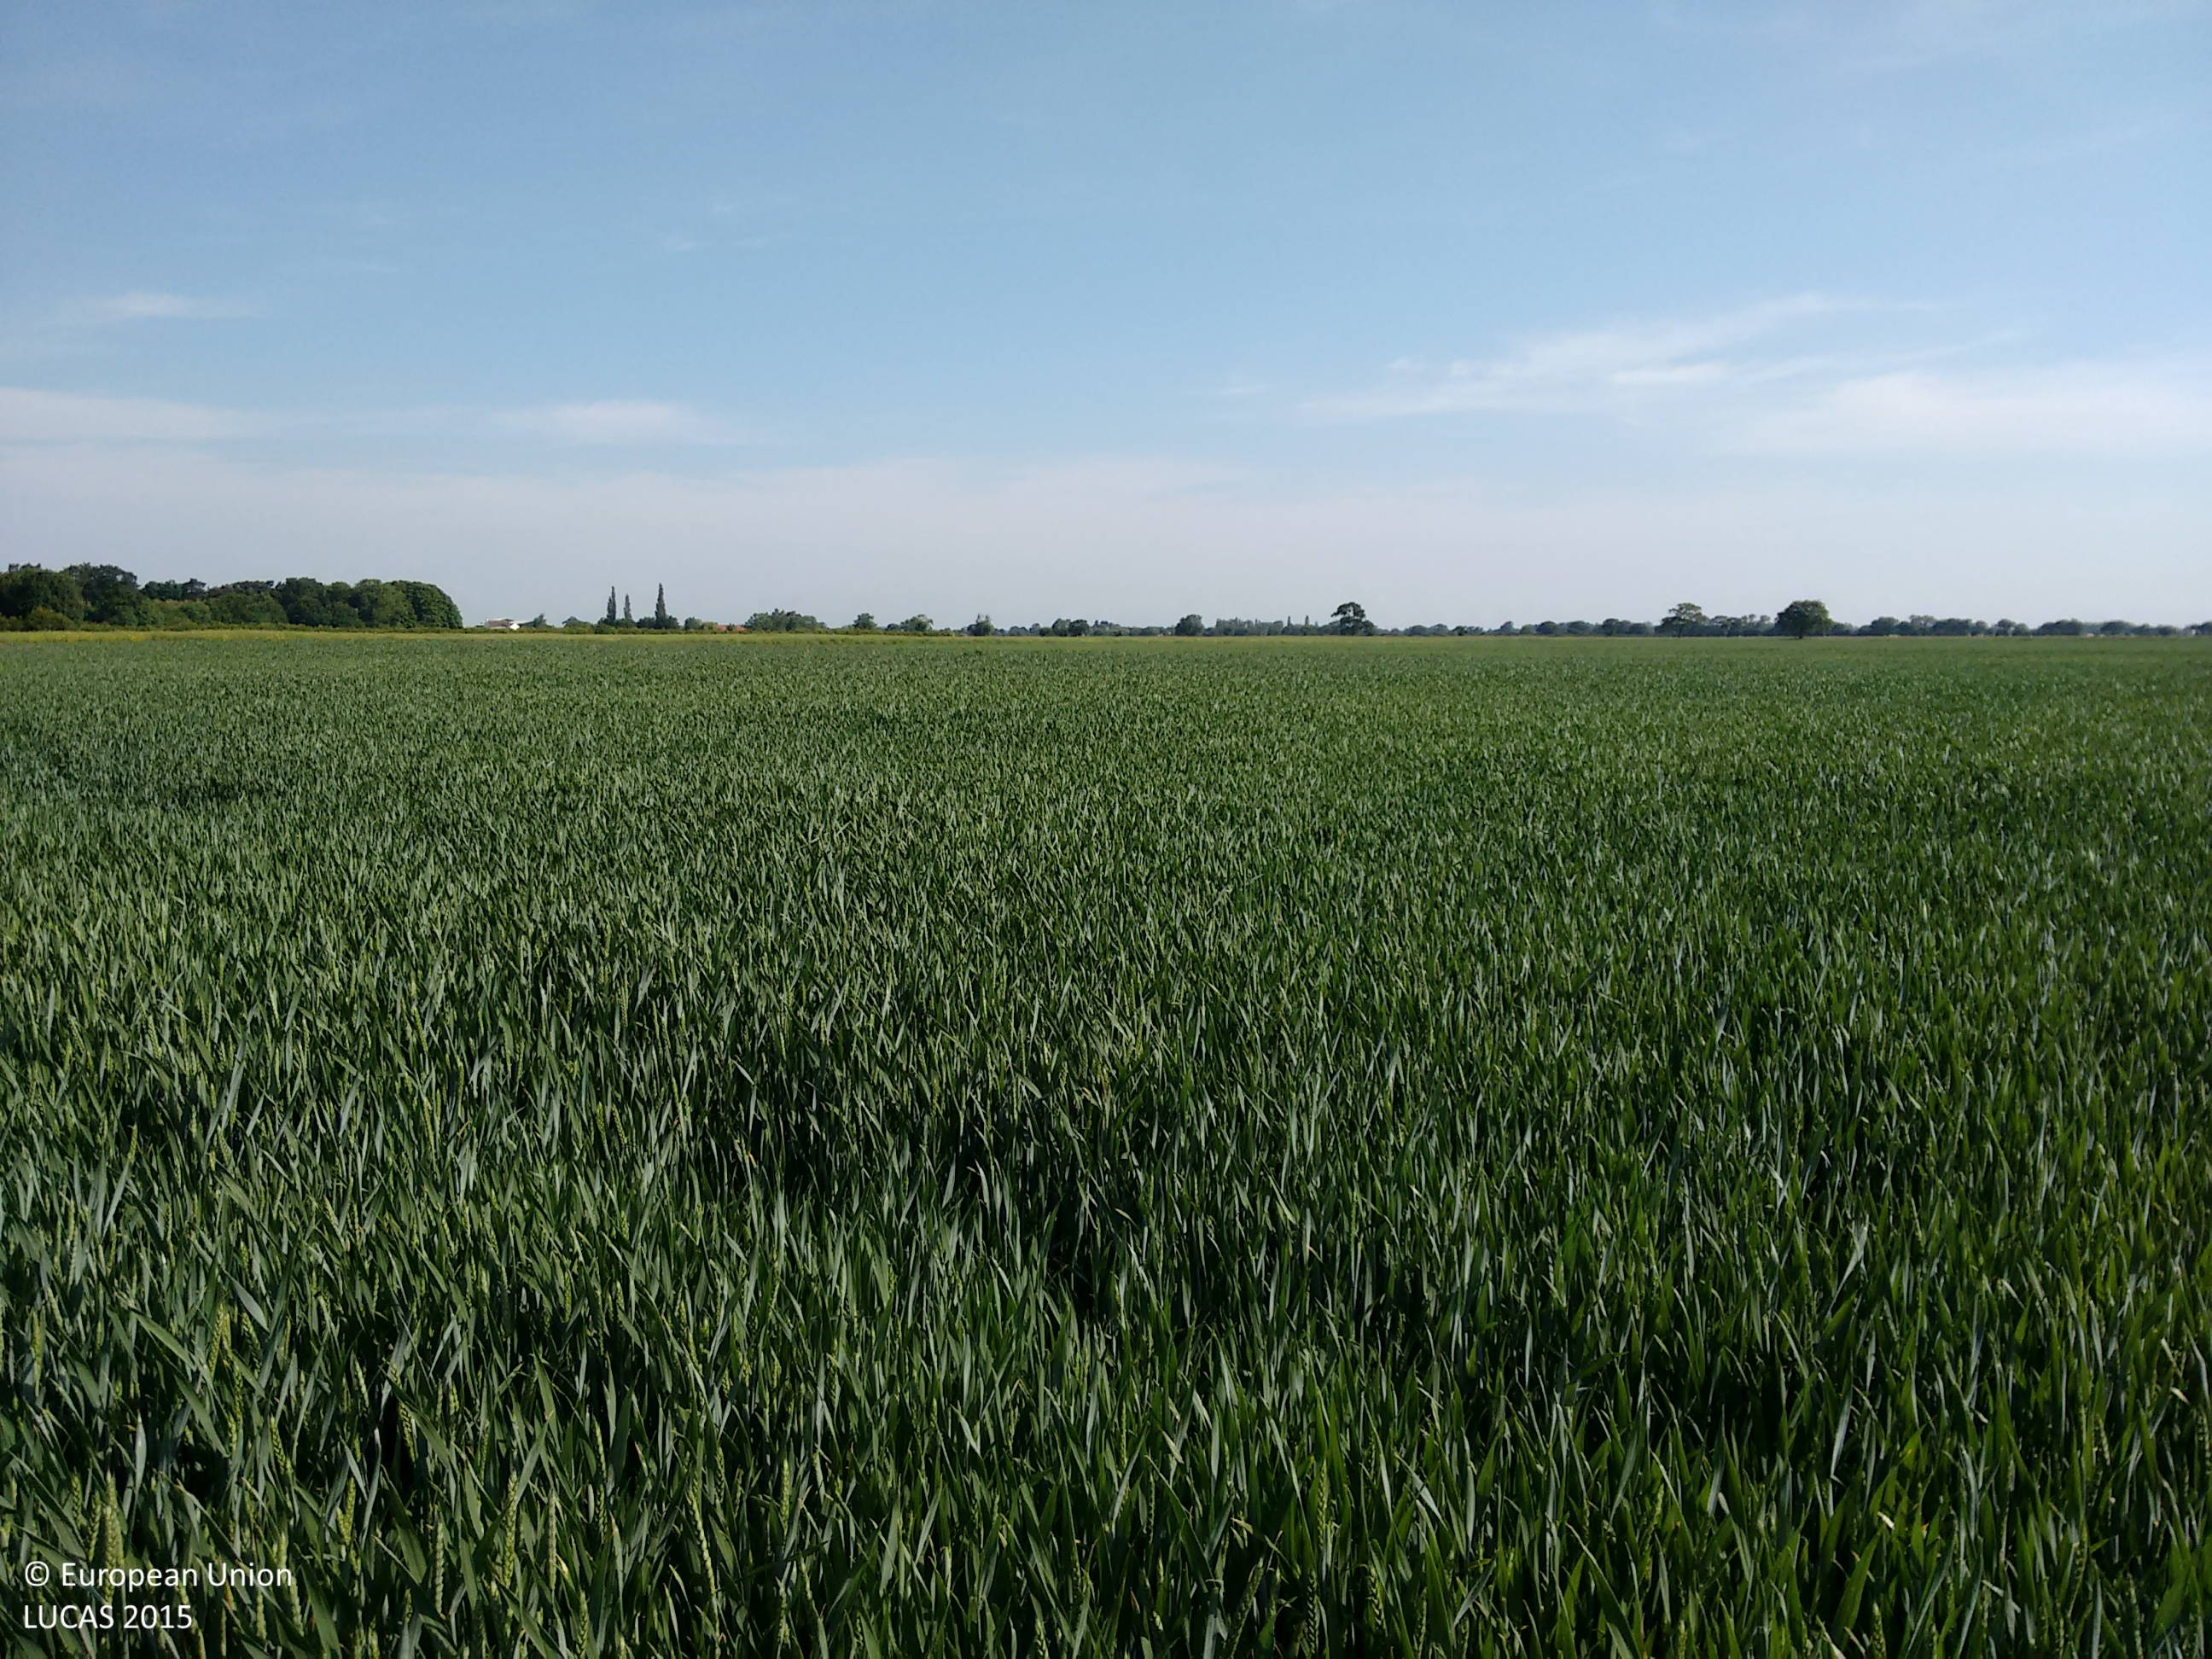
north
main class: Cropland
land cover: Common wheat
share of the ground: > 75 %
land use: Agriculture (excluding fallow land and kitchen gardens)
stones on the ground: < 10 %
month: June
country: GB
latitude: 53.7938
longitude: -1.1419
